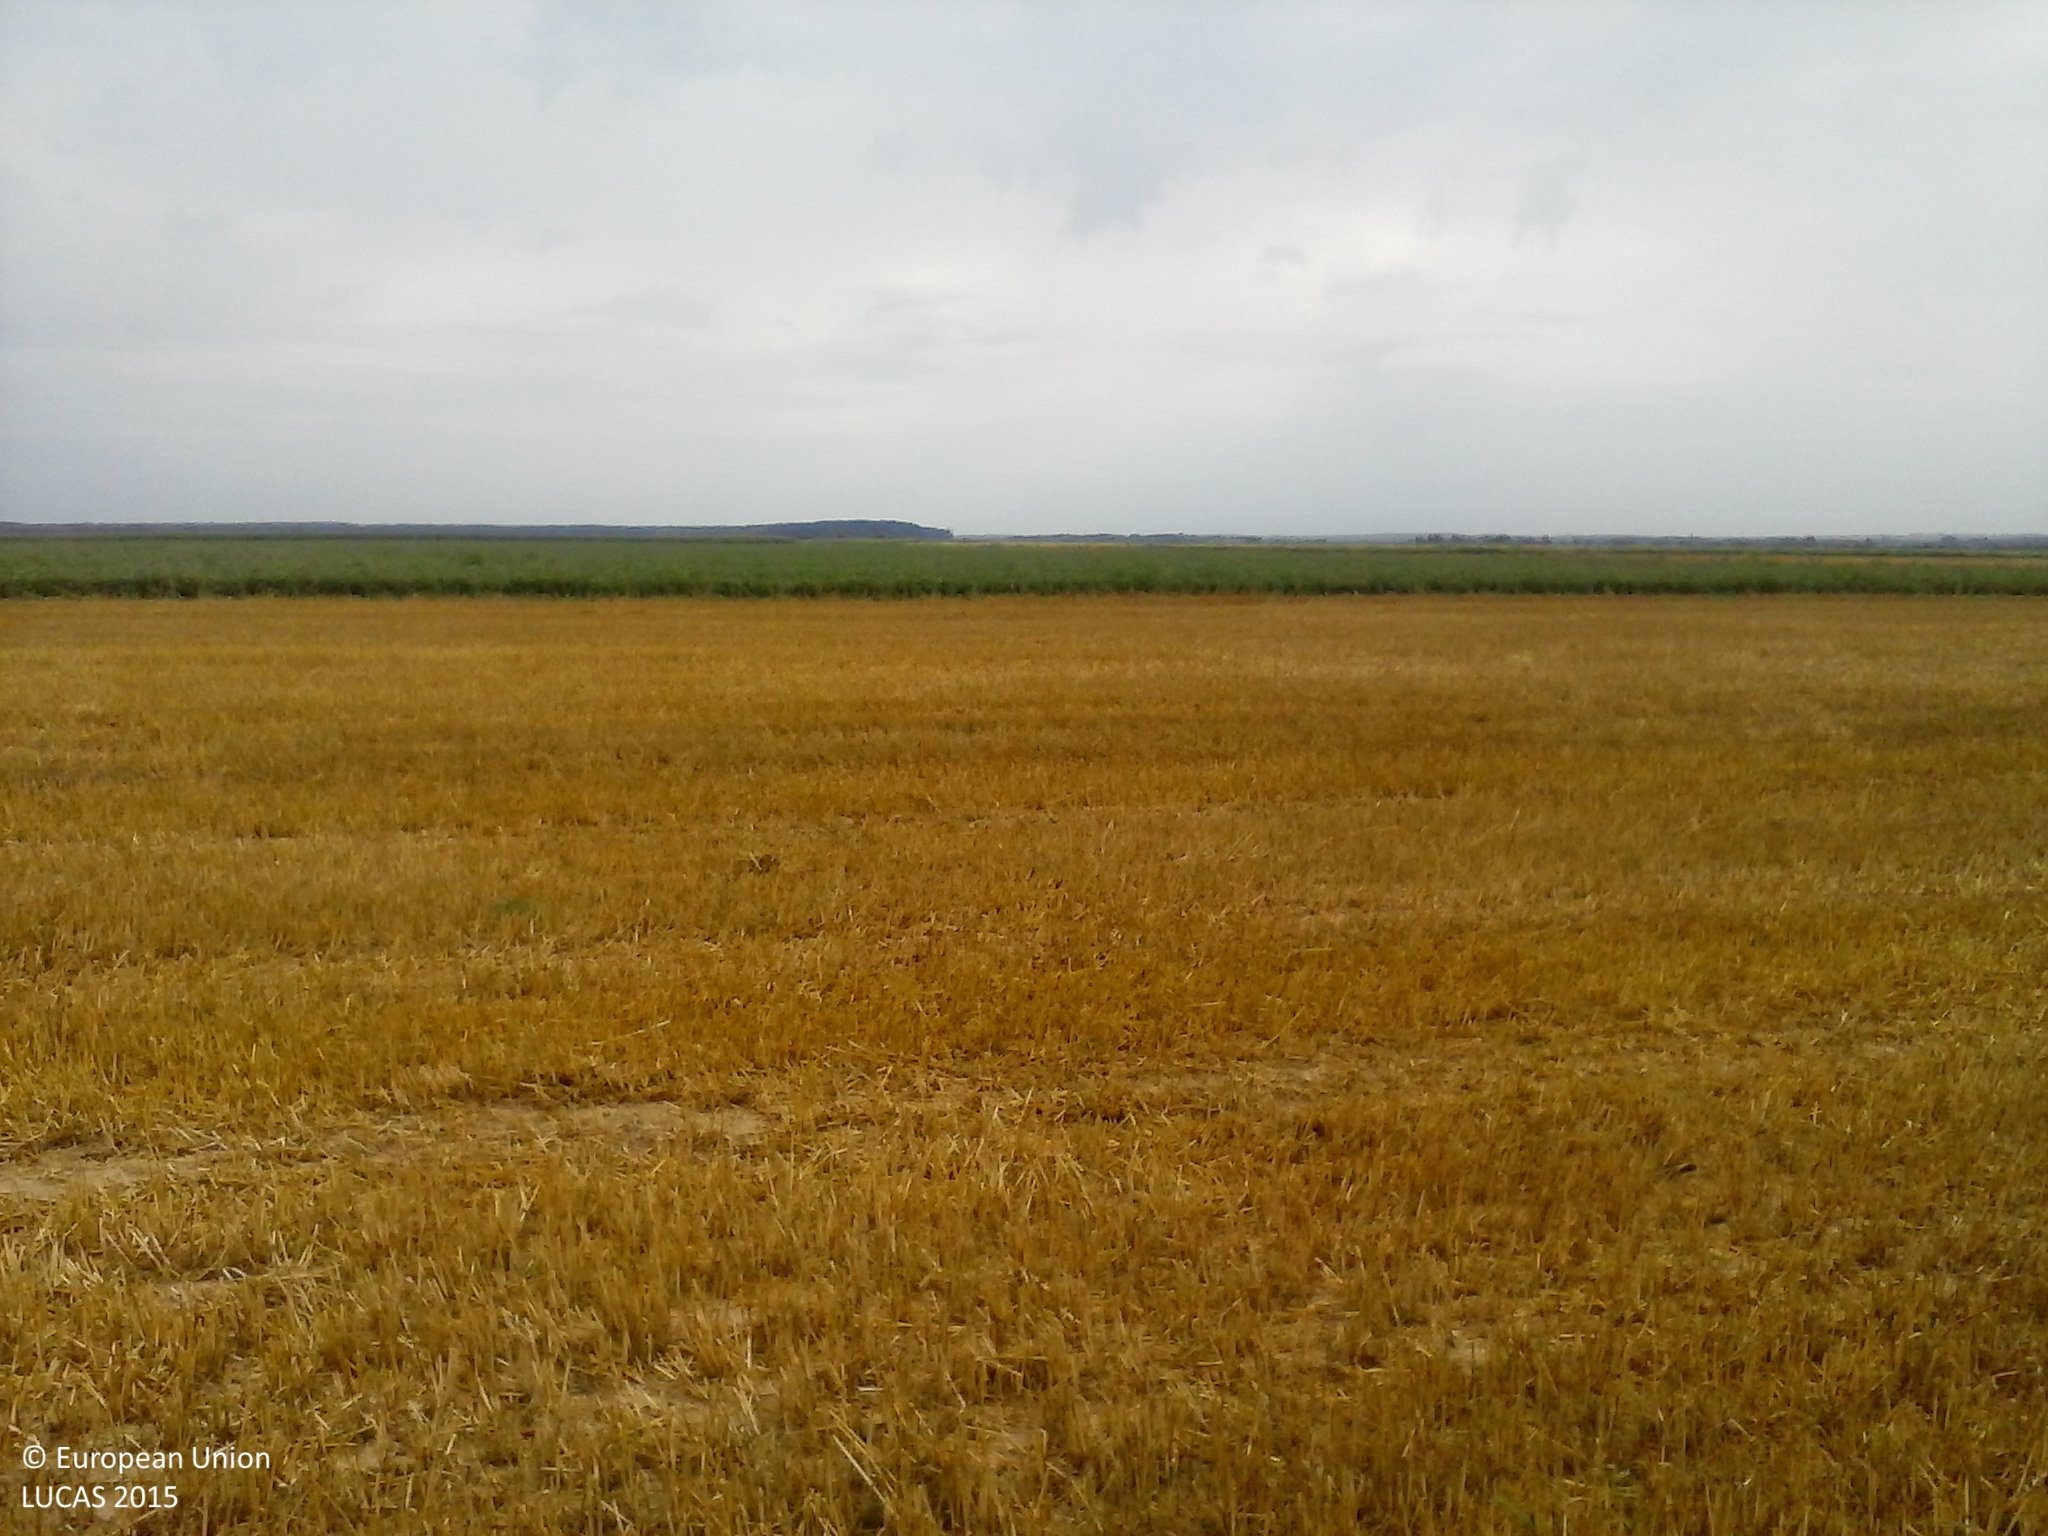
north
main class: Cropland
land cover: Durum wheat
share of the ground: > 75 %
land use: Agriculture (excluding fallow land and kitchen gardens)
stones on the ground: < 10 %
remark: Harvested field
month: July
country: HU
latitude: 46.0396
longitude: 17.6667
